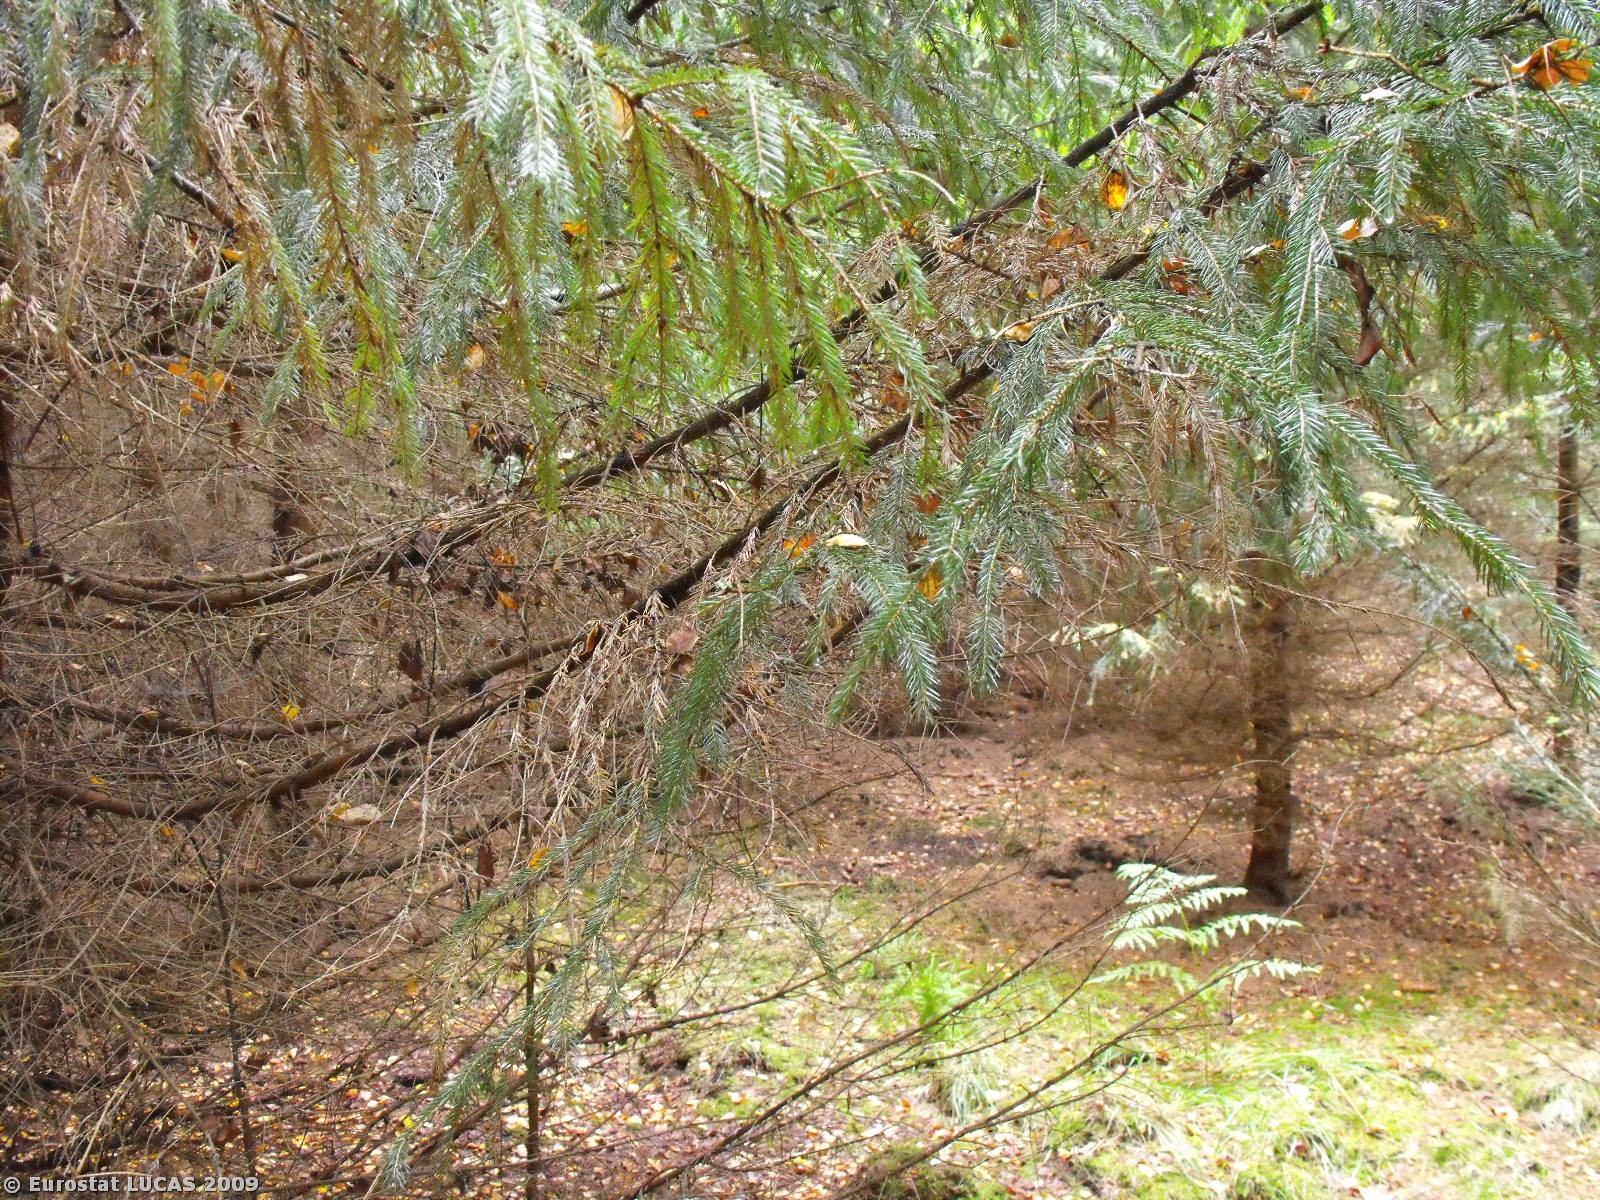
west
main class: Woodland
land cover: Coniferous woodland
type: hemiboreal forest and nemoral coniferous forest and mixed broadleaved-coniferous forest
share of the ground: > 75 %
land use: Forestry
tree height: > 5 m
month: September
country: PL
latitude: 53.1041
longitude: 16.4445
